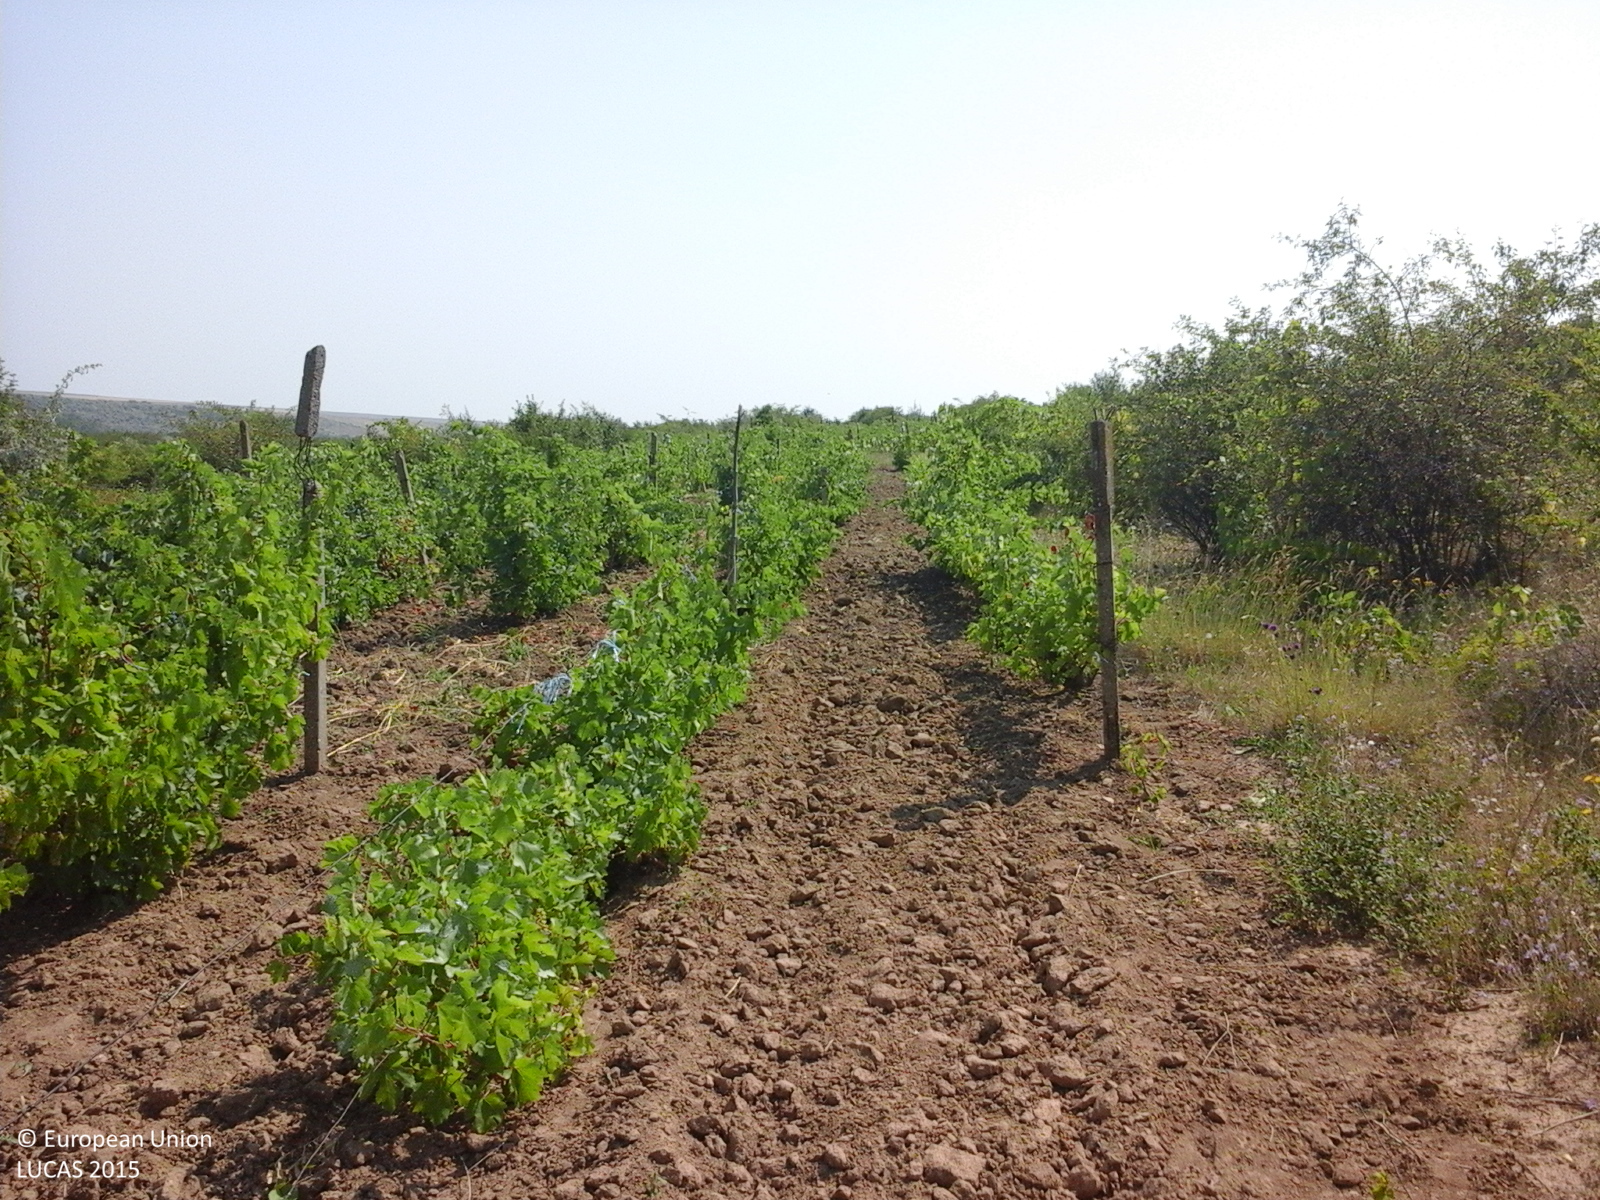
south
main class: Cropland
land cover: Vineyards
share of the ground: > 75 %
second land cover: Other bare soil
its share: > 75 %
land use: Agriculture (excluding fallow land and kitchen gardens)
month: July
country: RO
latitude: 45.6128
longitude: 27.8221
